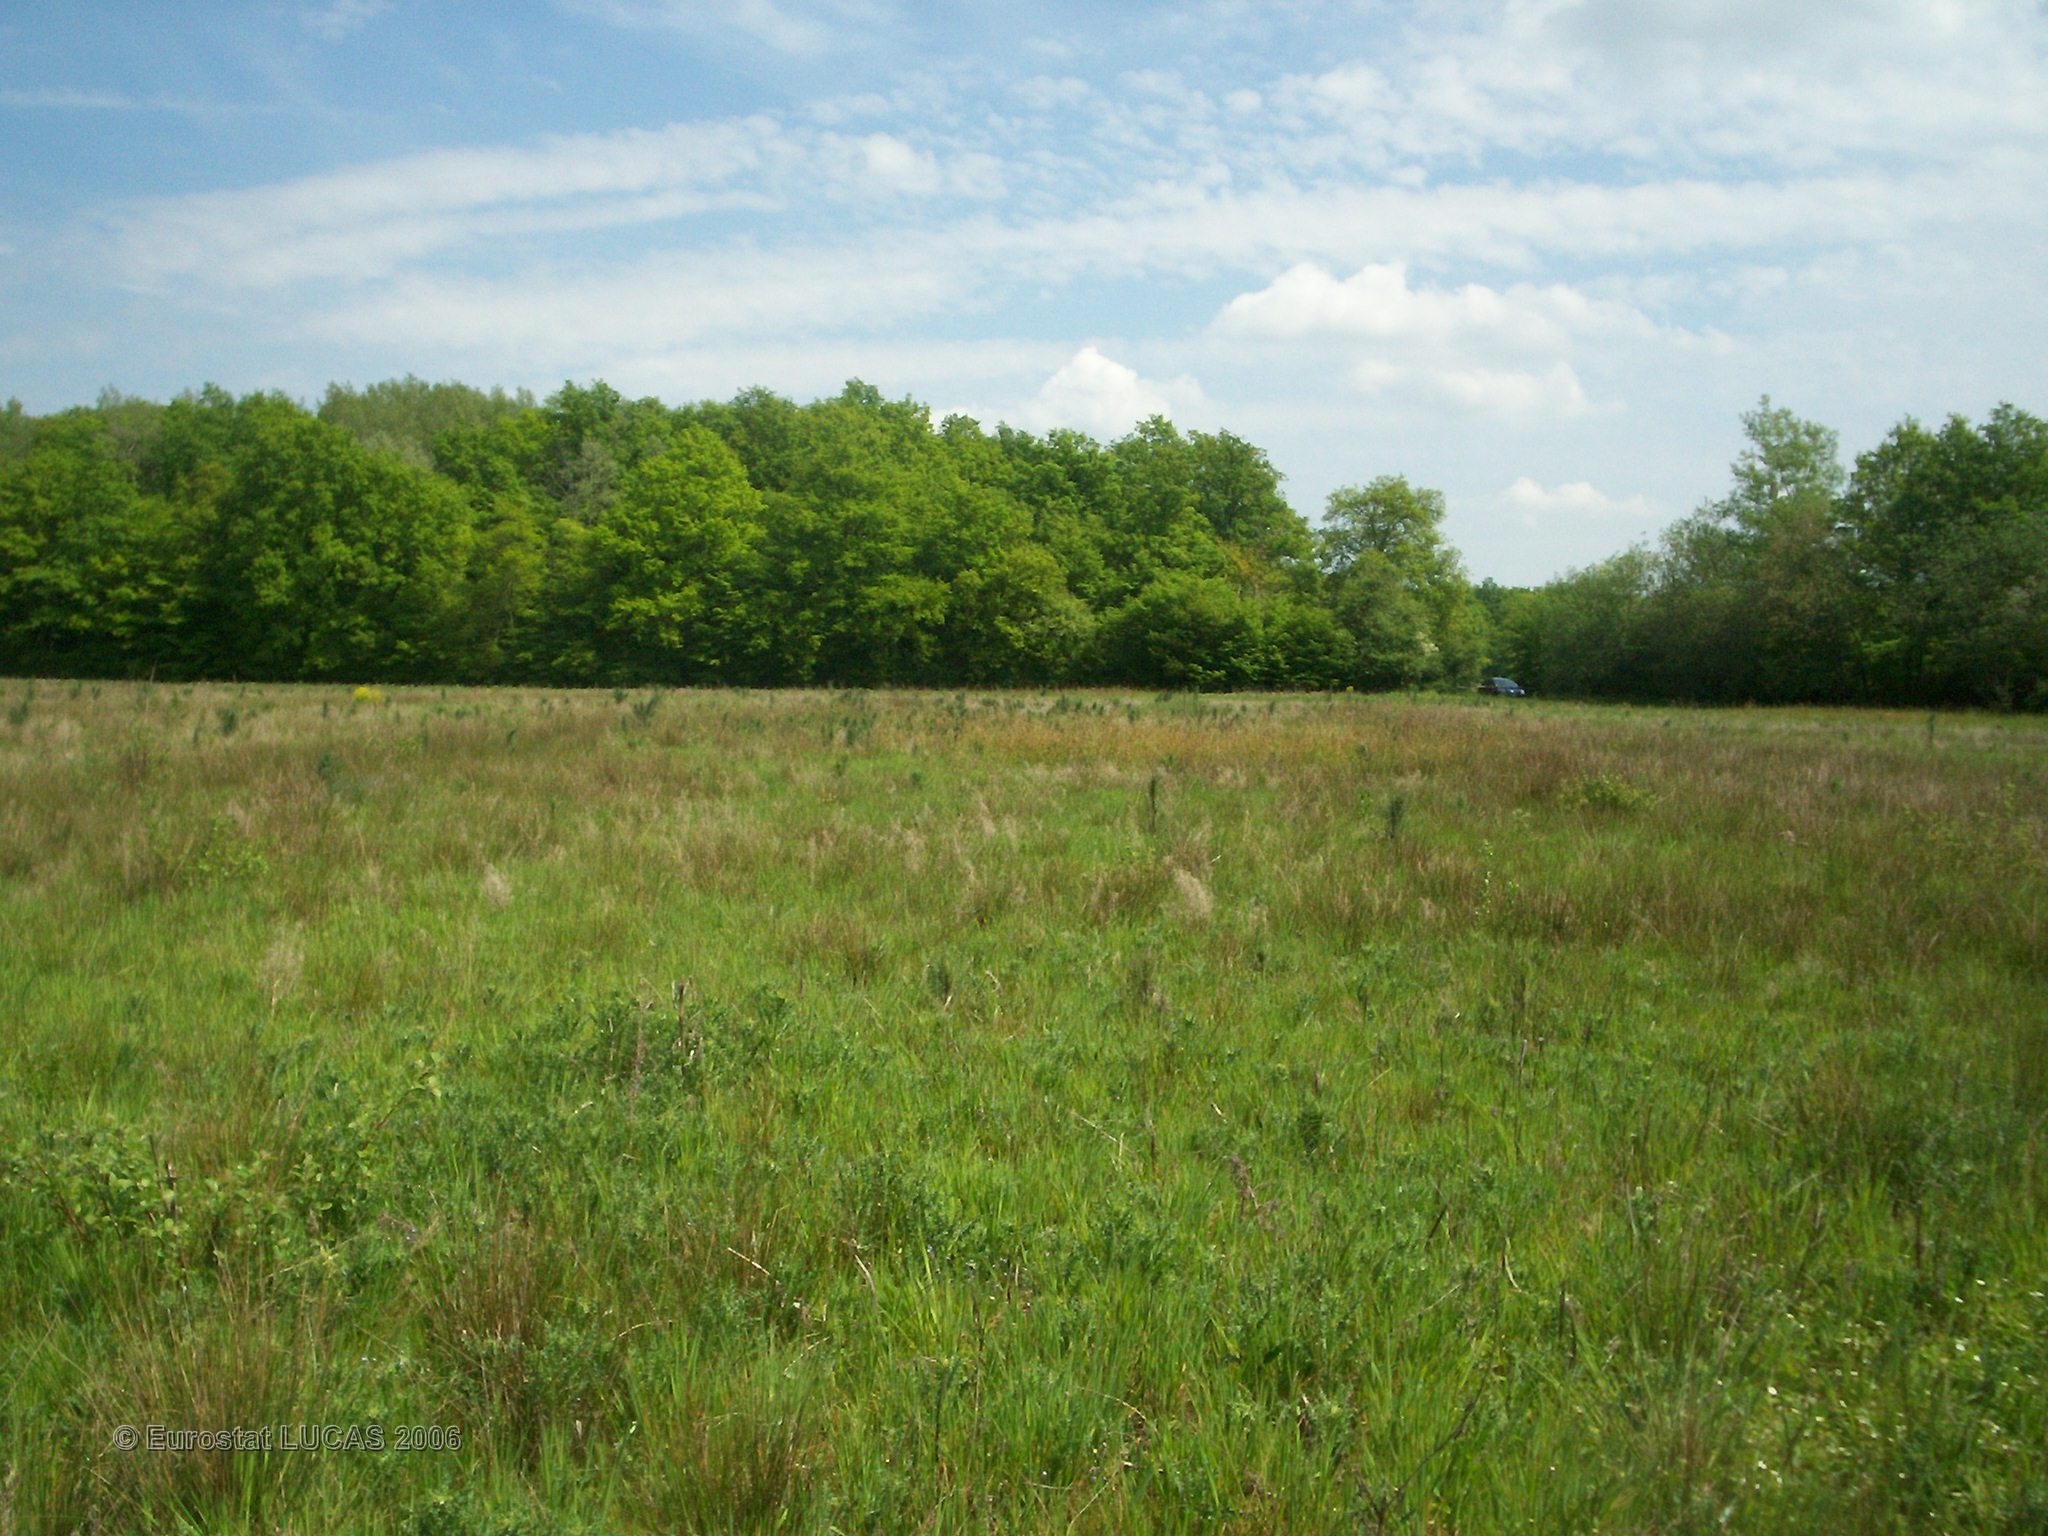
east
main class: Grassland
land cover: Grassland without tree/shrub cover
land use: Agriculture (excluding fallow land and kitchen gardens)
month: May
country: FR
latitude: 47.6384
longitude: 2.9794
